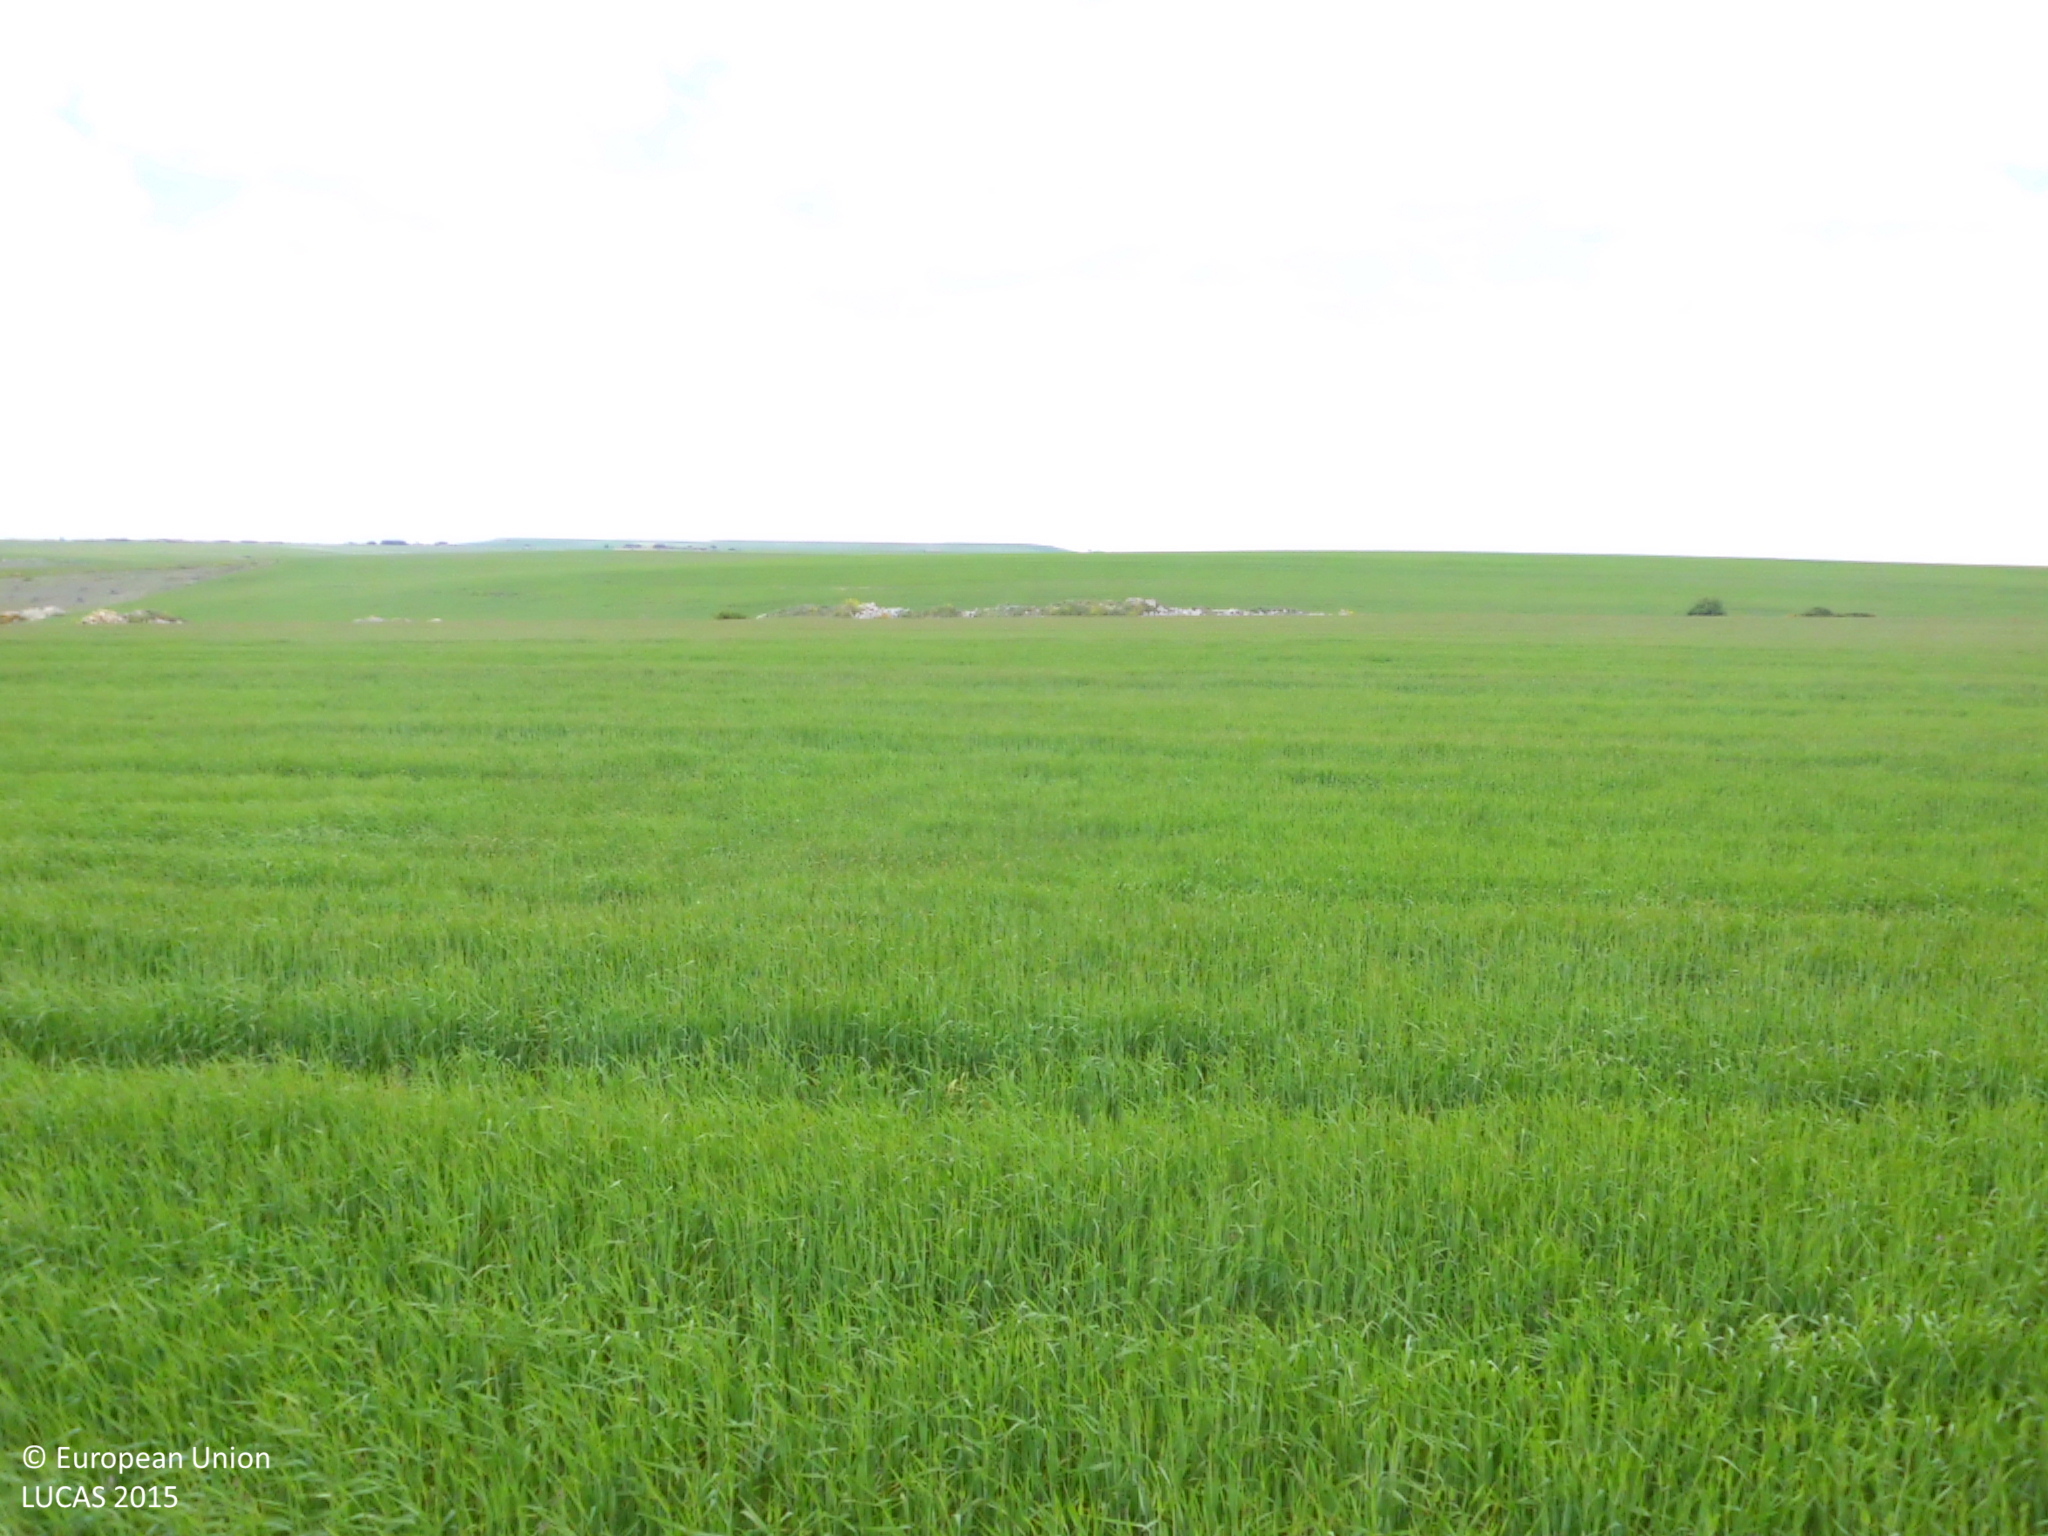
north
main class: Cropland
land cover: Barley
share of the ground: > 75 %
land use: Agriculture (excluding fallow land and kitchen gardens)
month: May
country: ES
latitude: 42.3193
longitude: -3.9820
